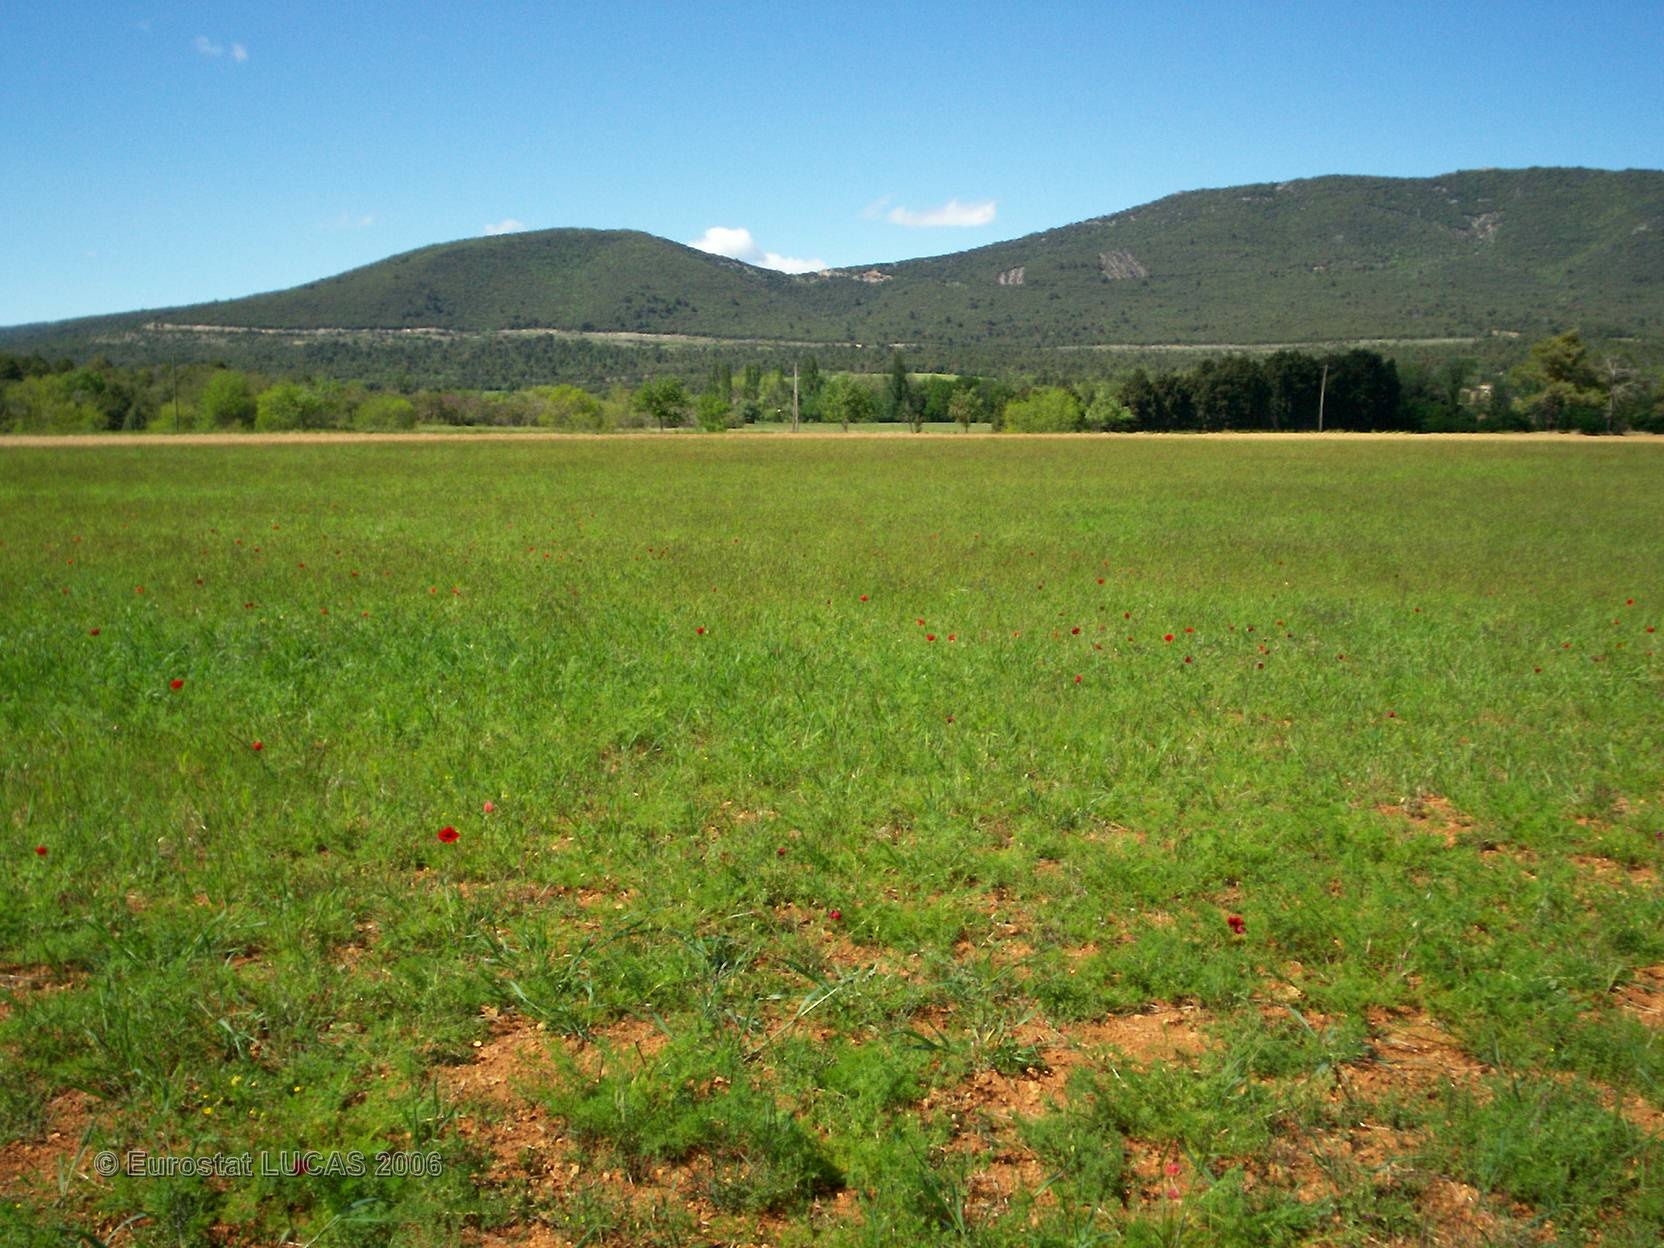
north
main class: Grassland
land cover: Grassland without tree/shrub cover
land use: Agriculture (excluding fallow land and kitchen gardens)
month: May
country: FR
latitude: 43.6183
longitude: 6.3529
